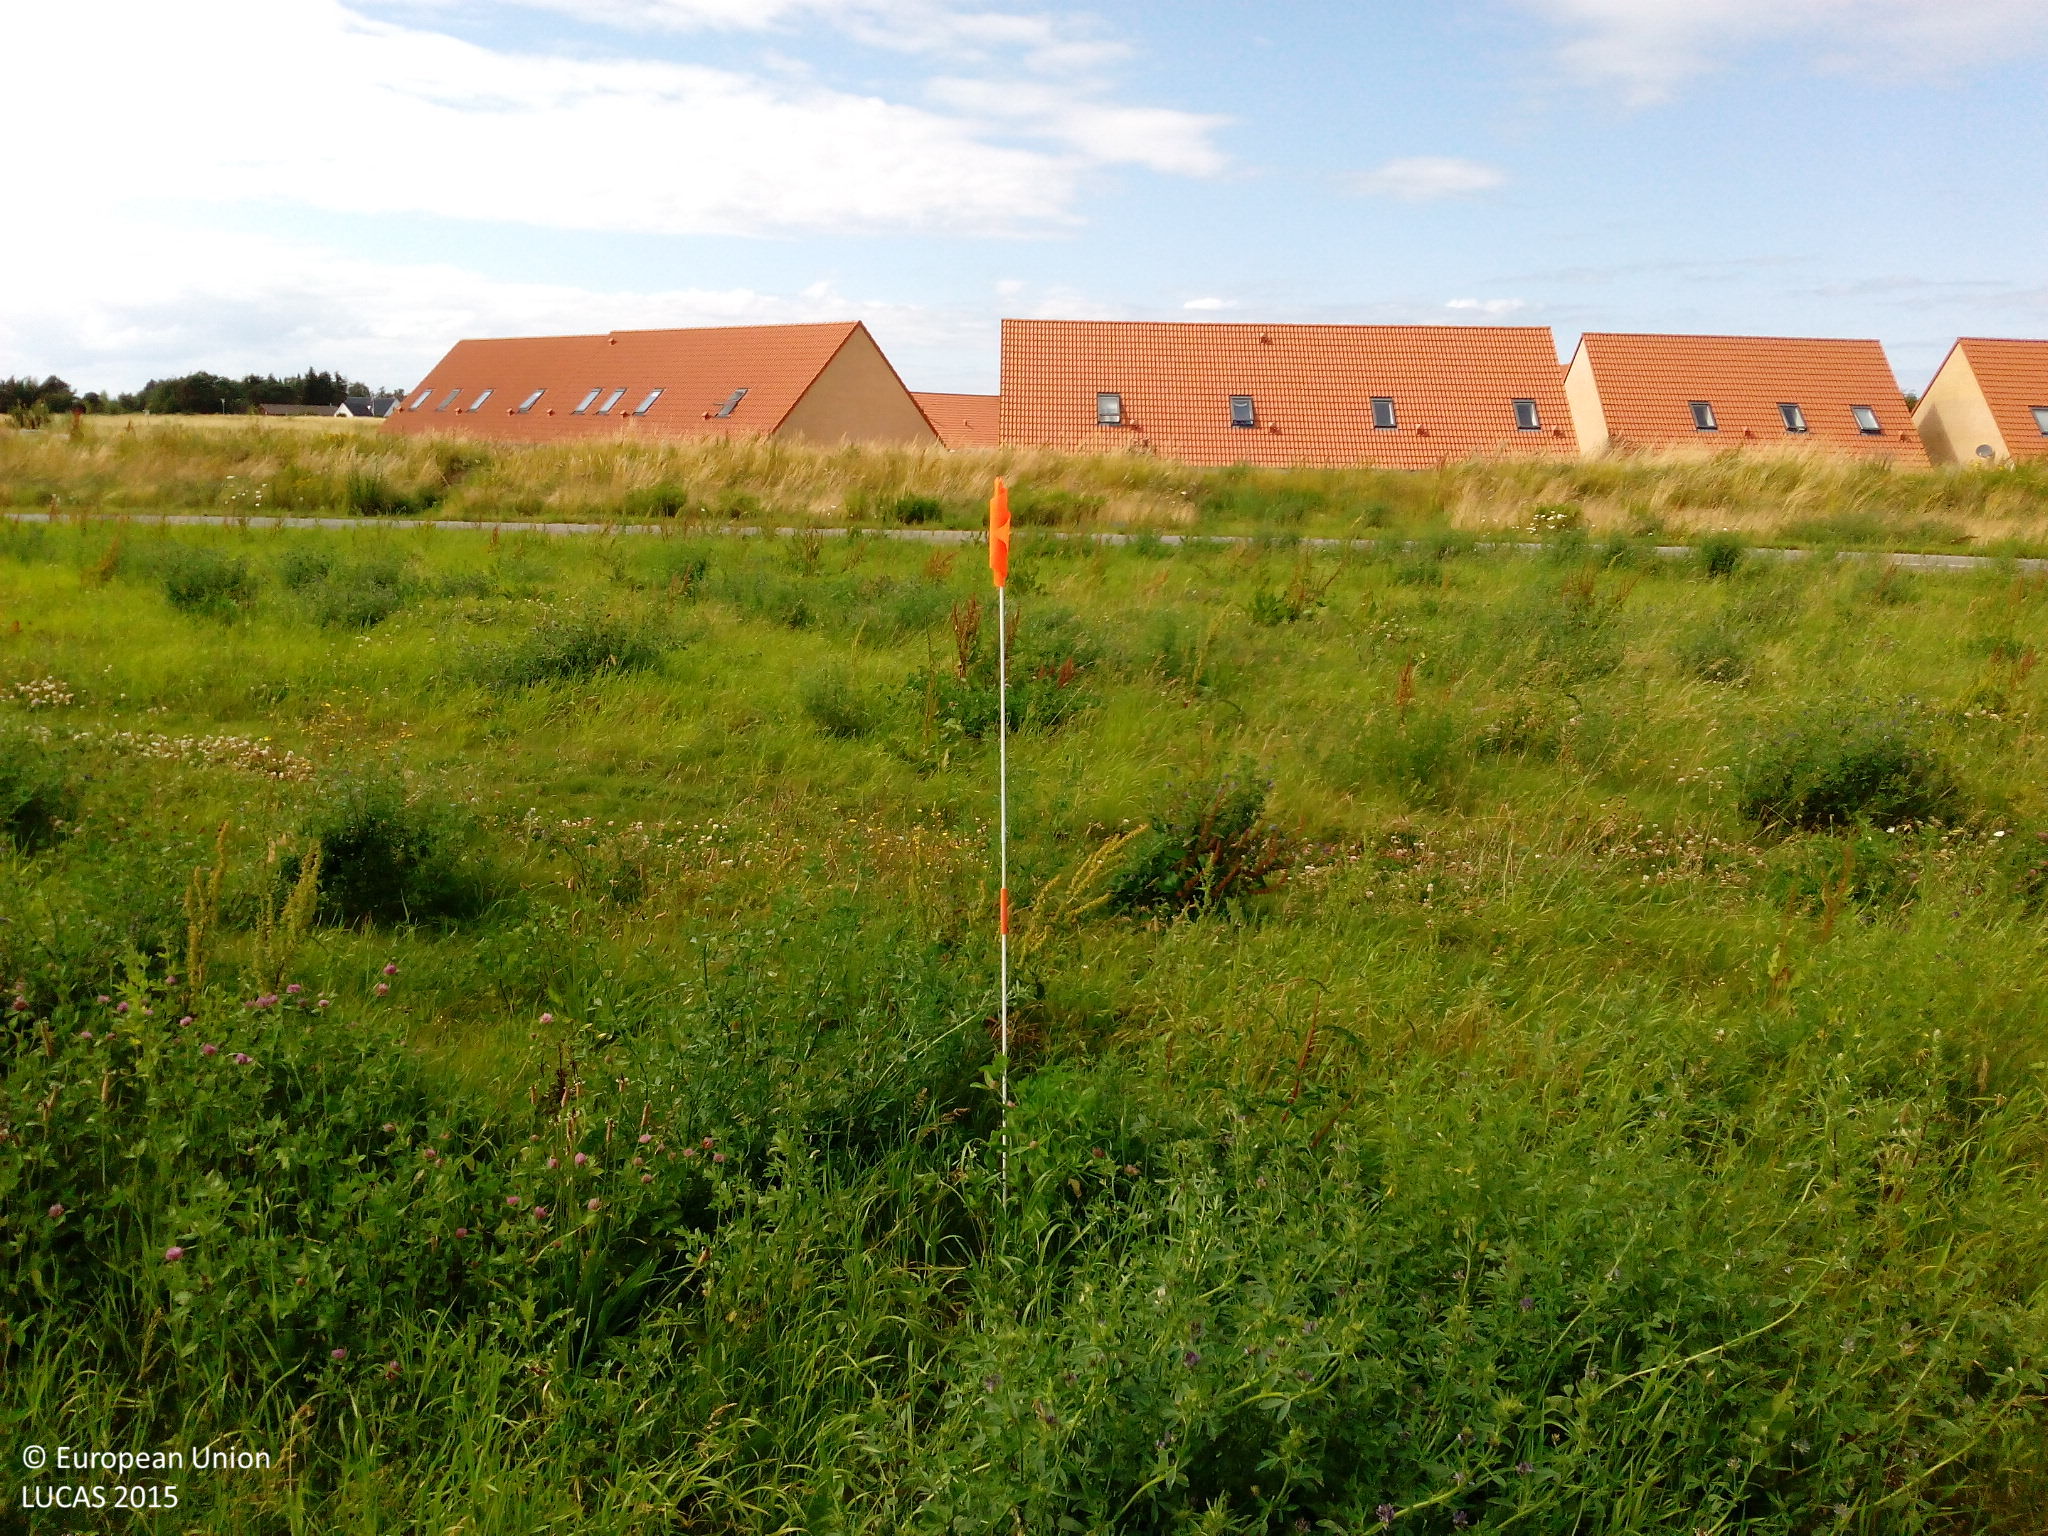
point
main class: Grassland
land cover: Grassland without tree/shrub cover
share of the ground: > 75 %
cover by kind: herbaceous plants 100 %
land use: Amenities, museums, leisure
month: July
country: DK
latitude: 55.7495
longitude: 11.3210
